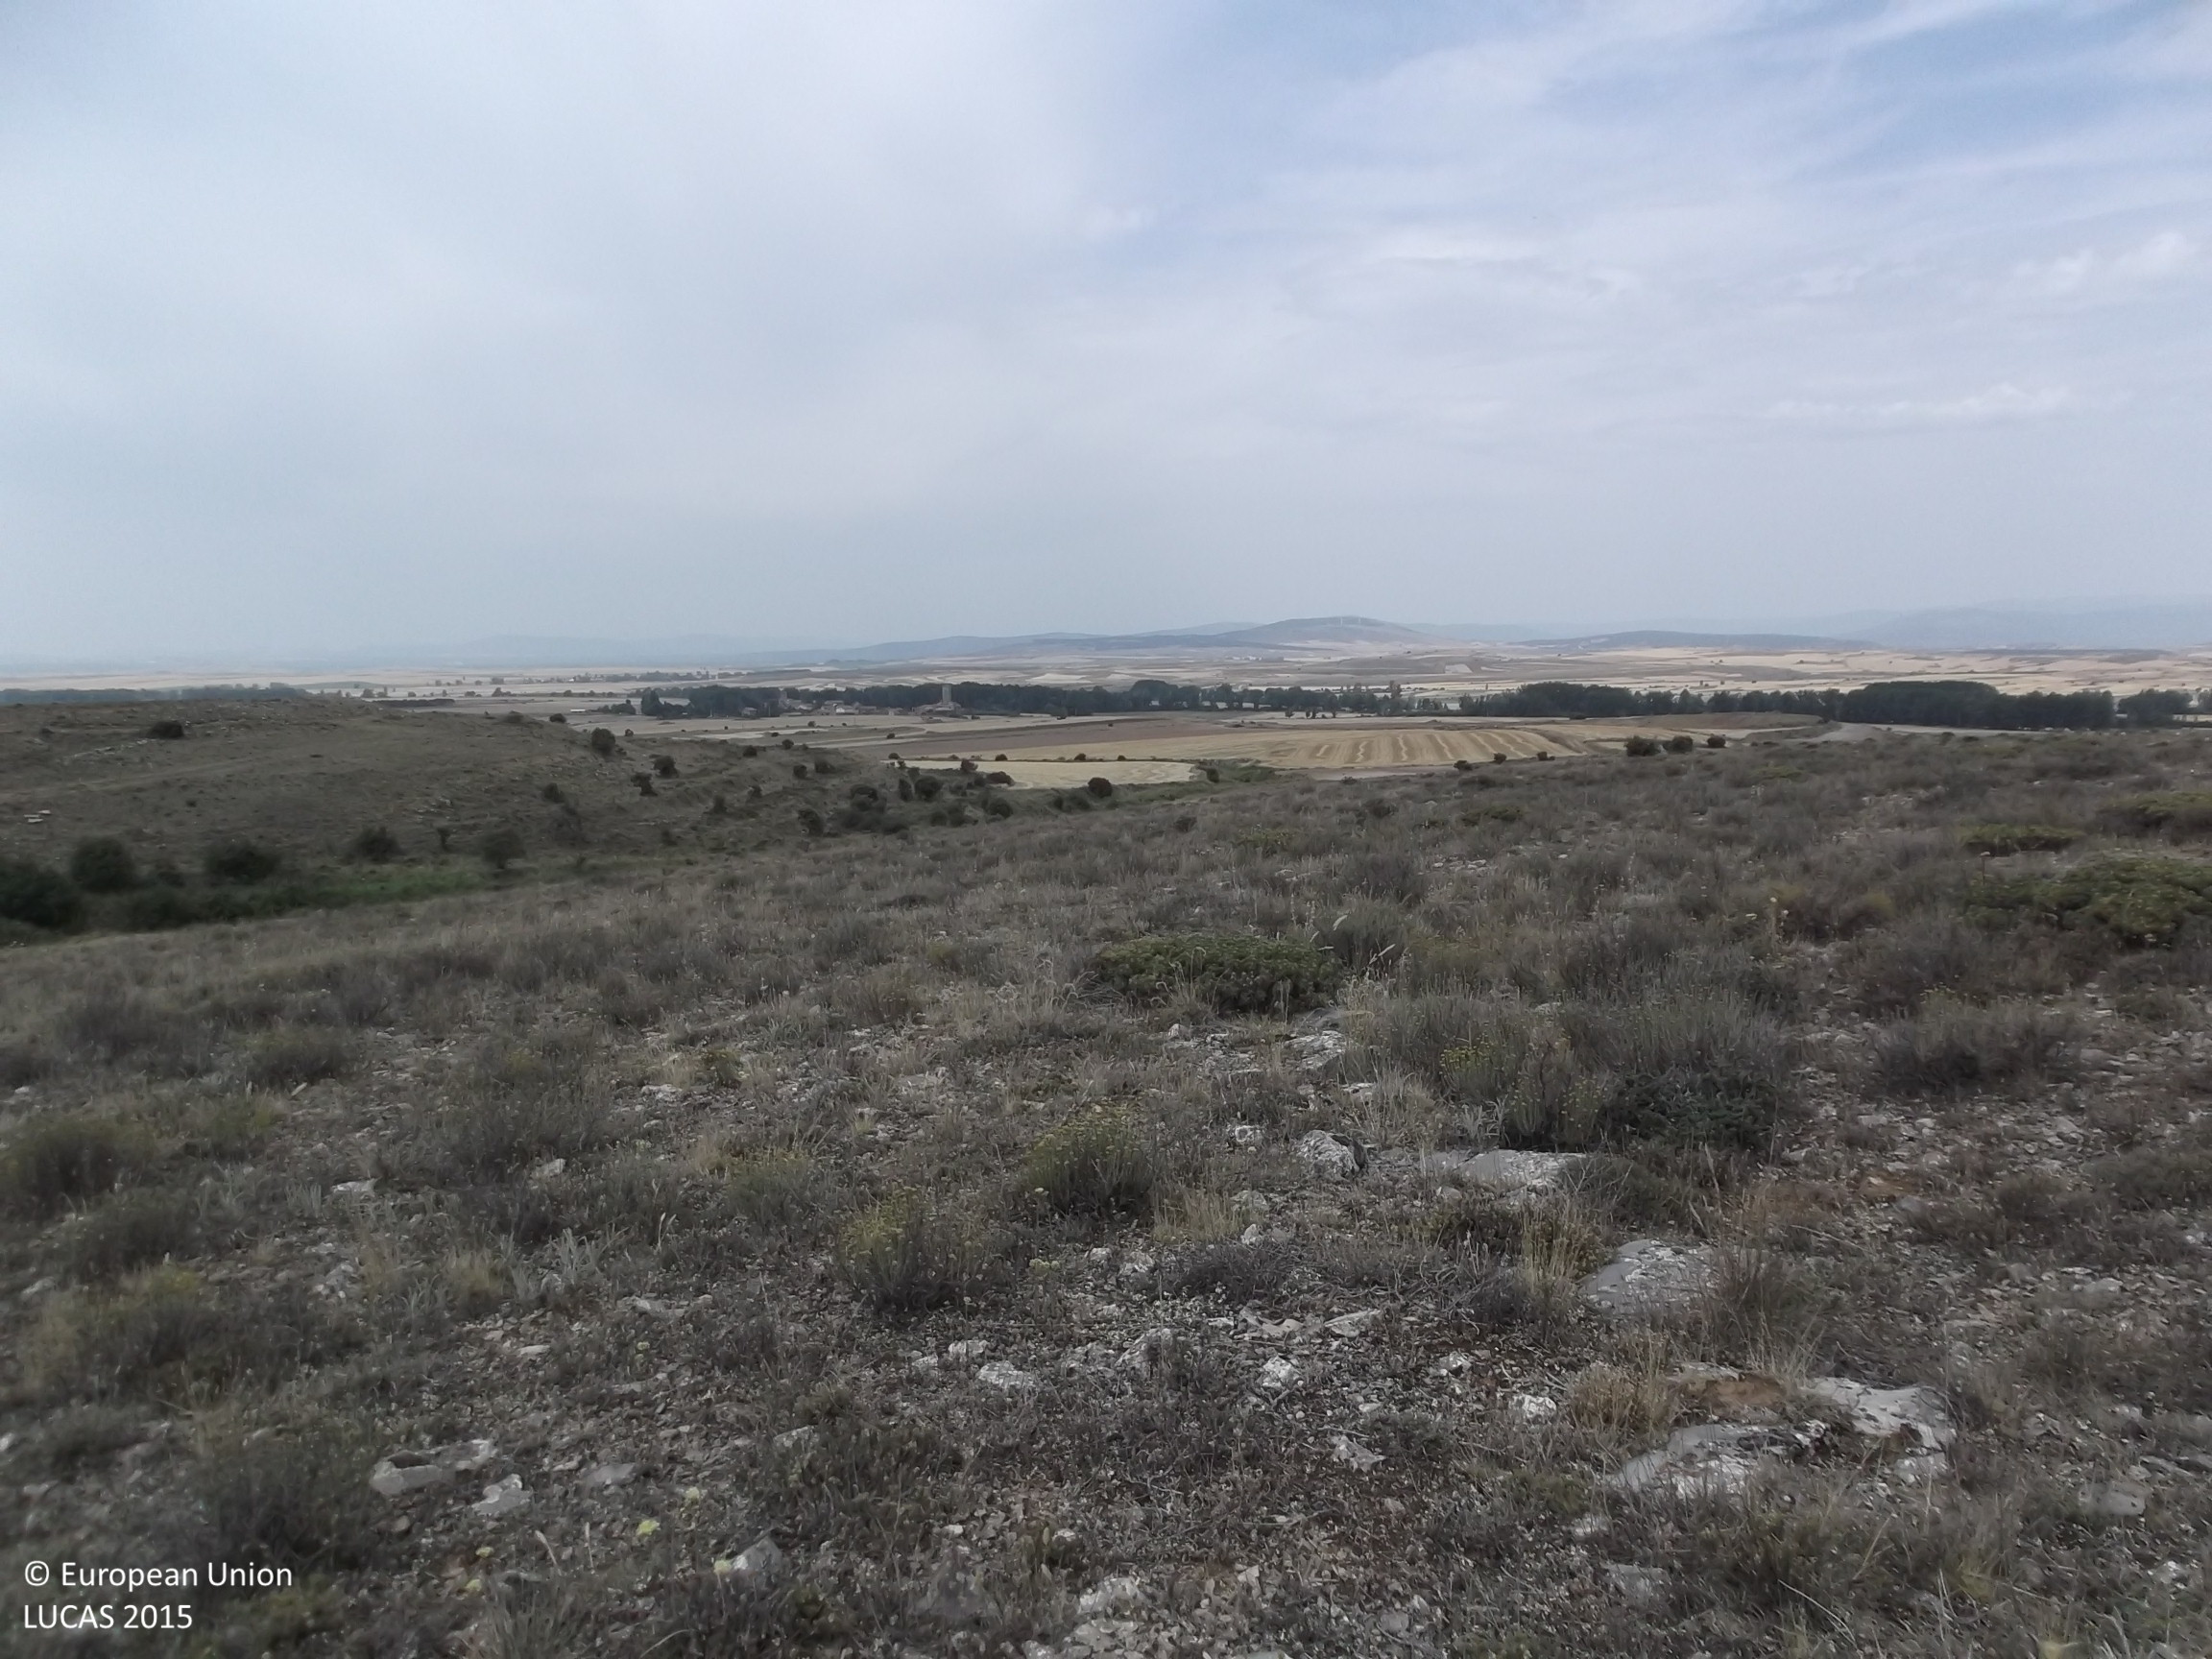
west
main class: Shrubland
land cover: Shrubland without tree cover
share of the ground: 50 - 75 %
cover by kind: shrubs 60 %, unconsolidated bare surface 30 %, herbaceous plants 10 %
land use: Semi-natural and natural areas not in use
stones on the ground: > 50 %
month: July
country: ES
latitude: 41.8839
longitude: -2.2930
